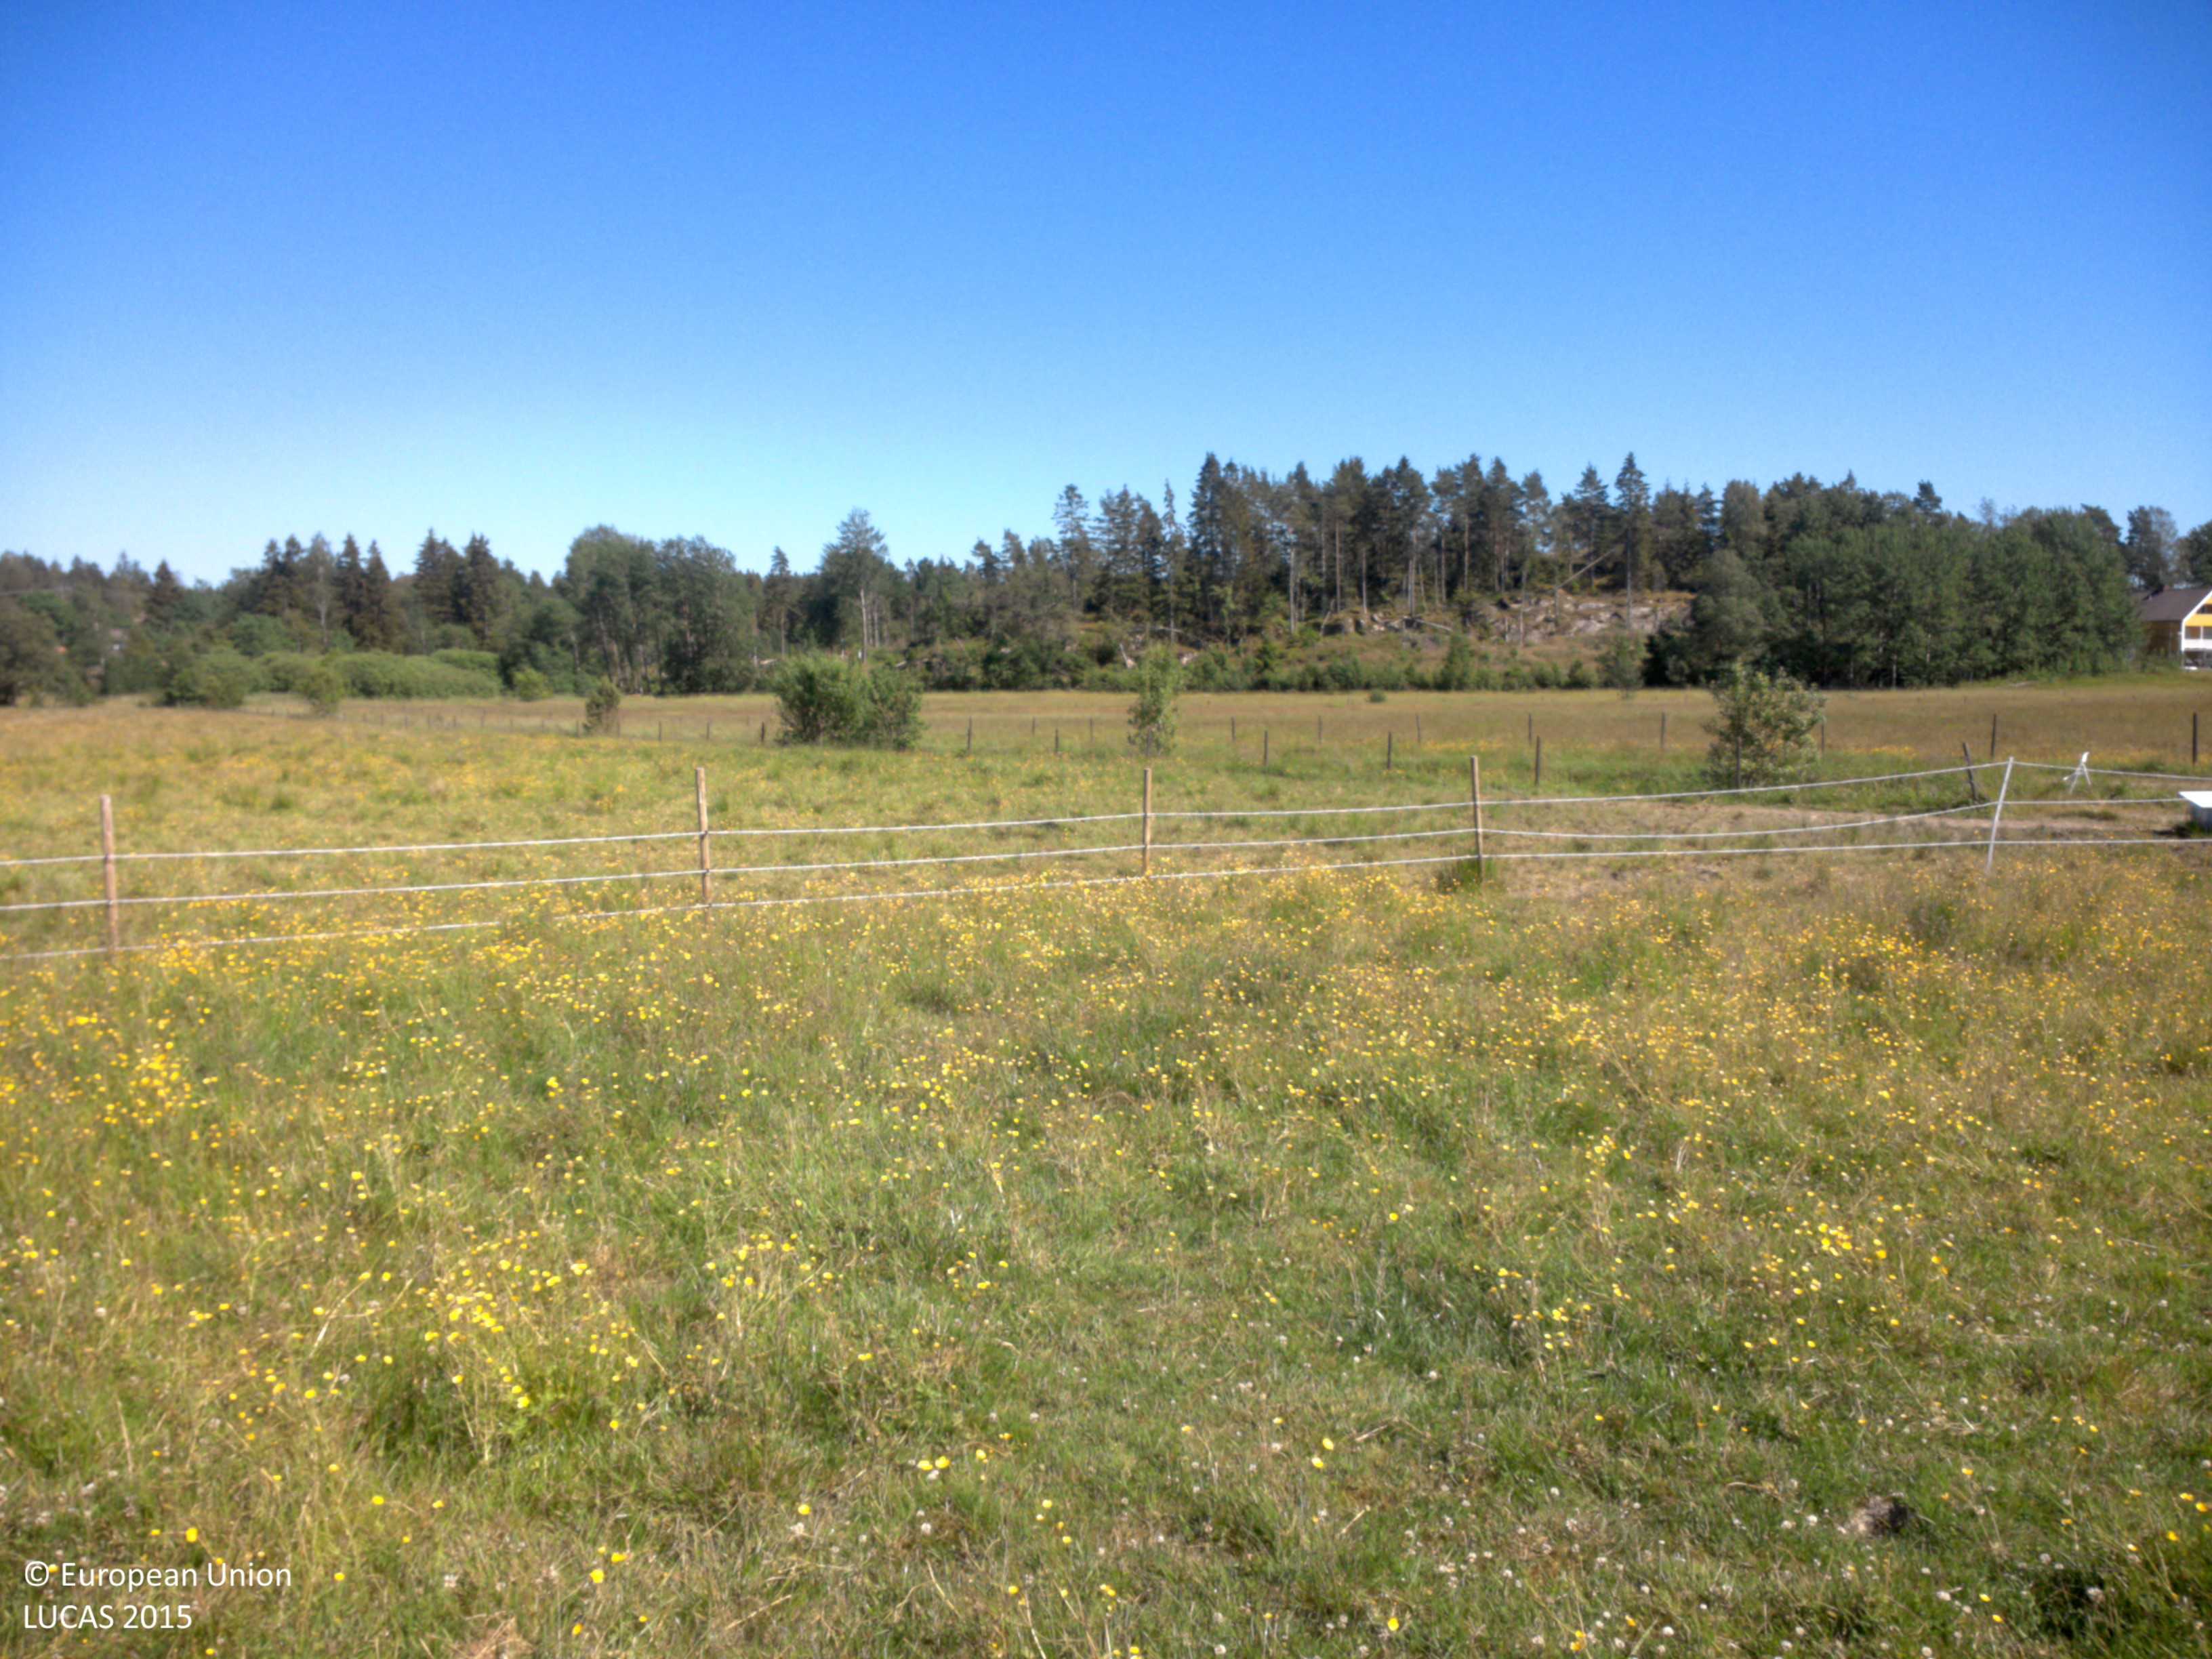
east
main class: Grassland
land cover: Grassland without tree/shrub cover
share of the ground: > 75 %
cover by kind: herbaceous plants 100 %
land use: Agriculture (excluding fallow land and kitchen gardens)
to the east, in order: Grassland without tree/shrub cover; Fences; Grassland without tree/shrub cover; Fences; Grass margins; Ditches and canals; Grass margins; Tracks; Grass margins; Fences; Grassland without tree/shrub cover; Fences; Grass margins; Tracks; Grassland without tree/shrub cover; Ditches and canals; Broadleaved woodland
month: July
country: SE
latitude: 58.3666
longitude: 11.9961
